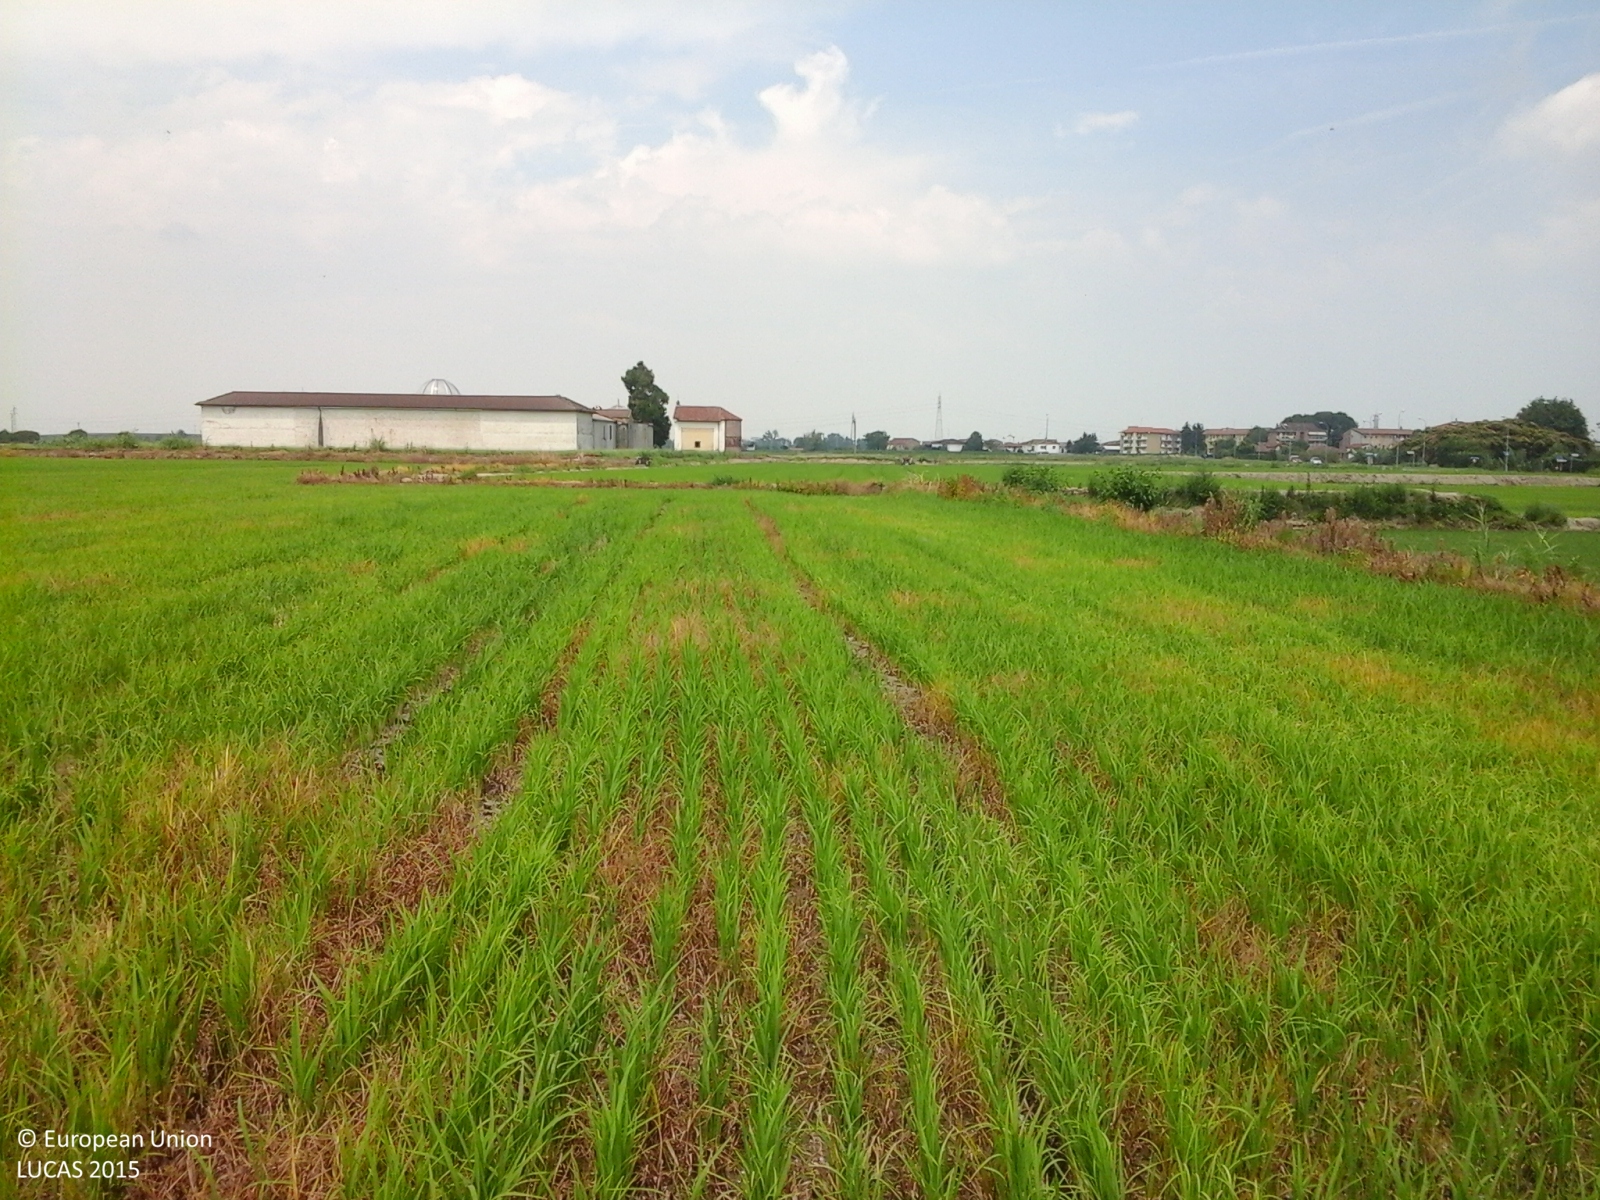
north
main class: Cropland
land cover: Rice
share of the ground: > 75 %
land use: Agriculture (excluding fallow land and kitchen gardens)
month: June
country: IT
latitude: 45.4048
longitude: 8.5843
